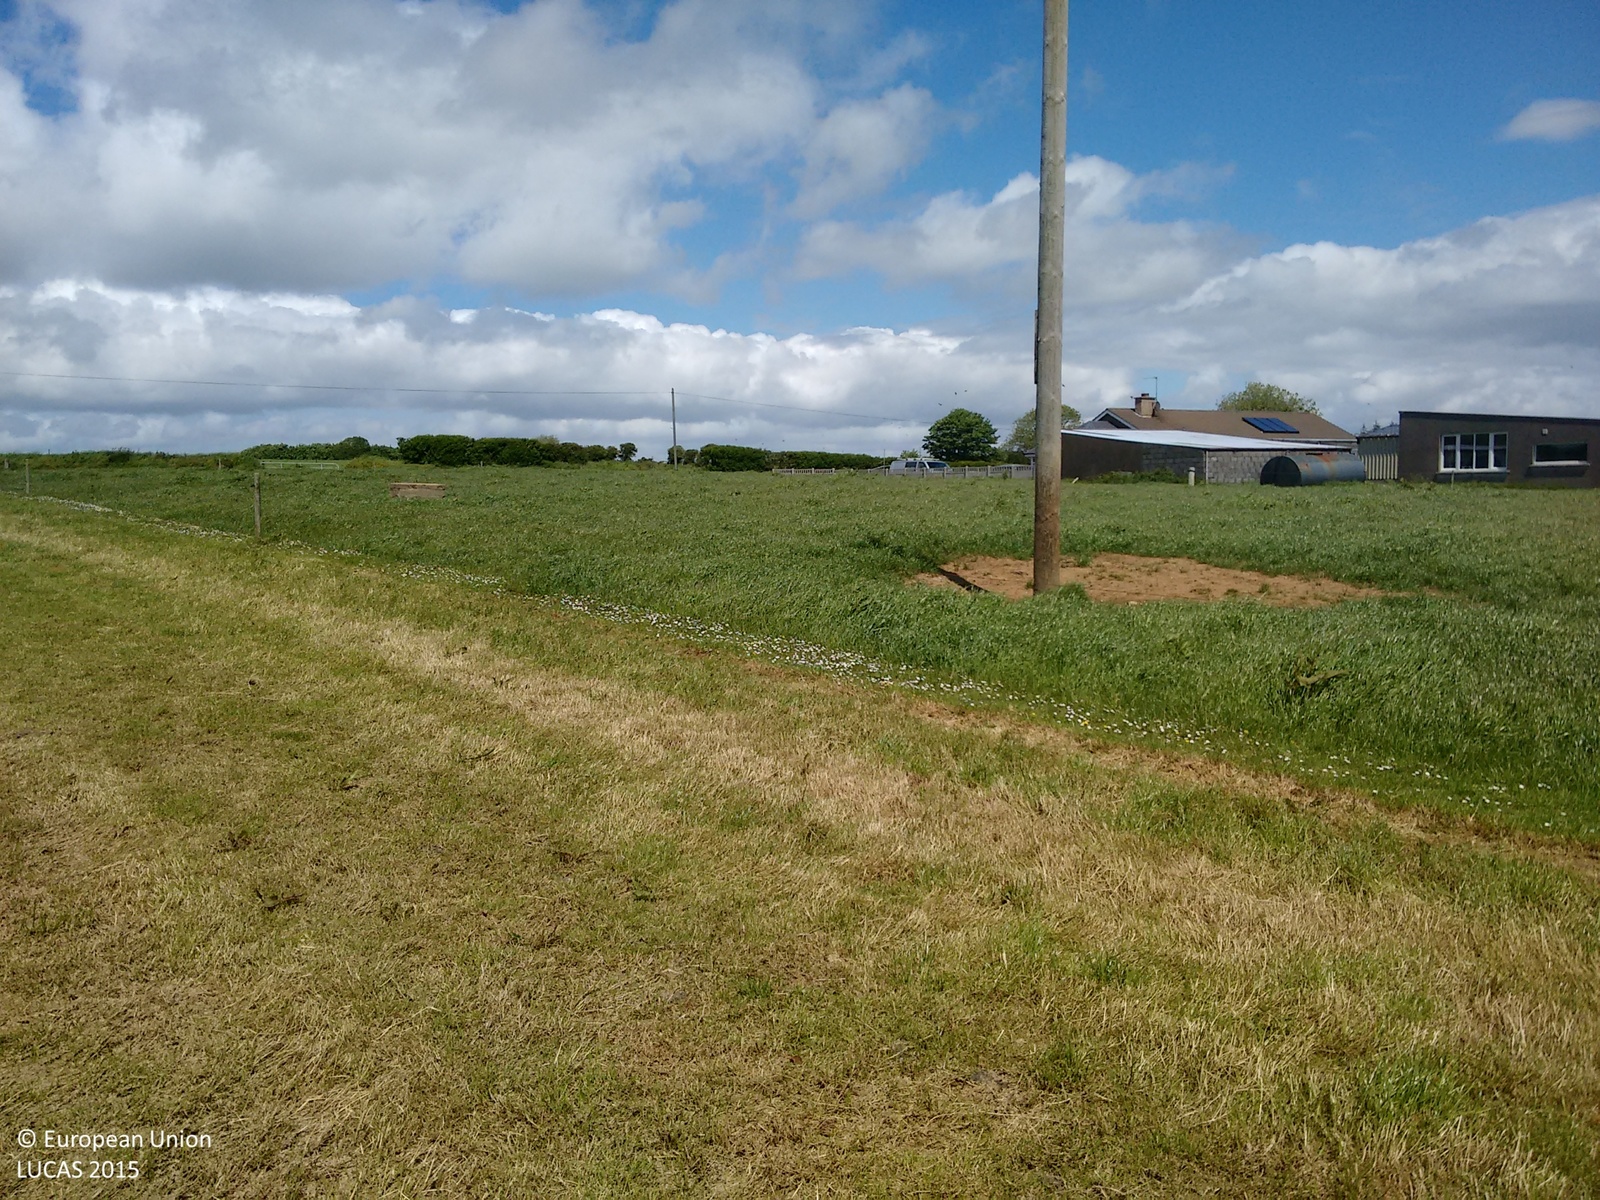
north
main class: Grassland
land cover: Grassland without tree/shrub cover
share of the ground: > 75 %
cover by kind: herbaceous plants 80 %, unconsolidated bare surface 20 %
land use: Agriculture (excluding fallow land and kitchen gardens)
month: June
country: IE
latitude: 51.6673
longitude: -8.6937
